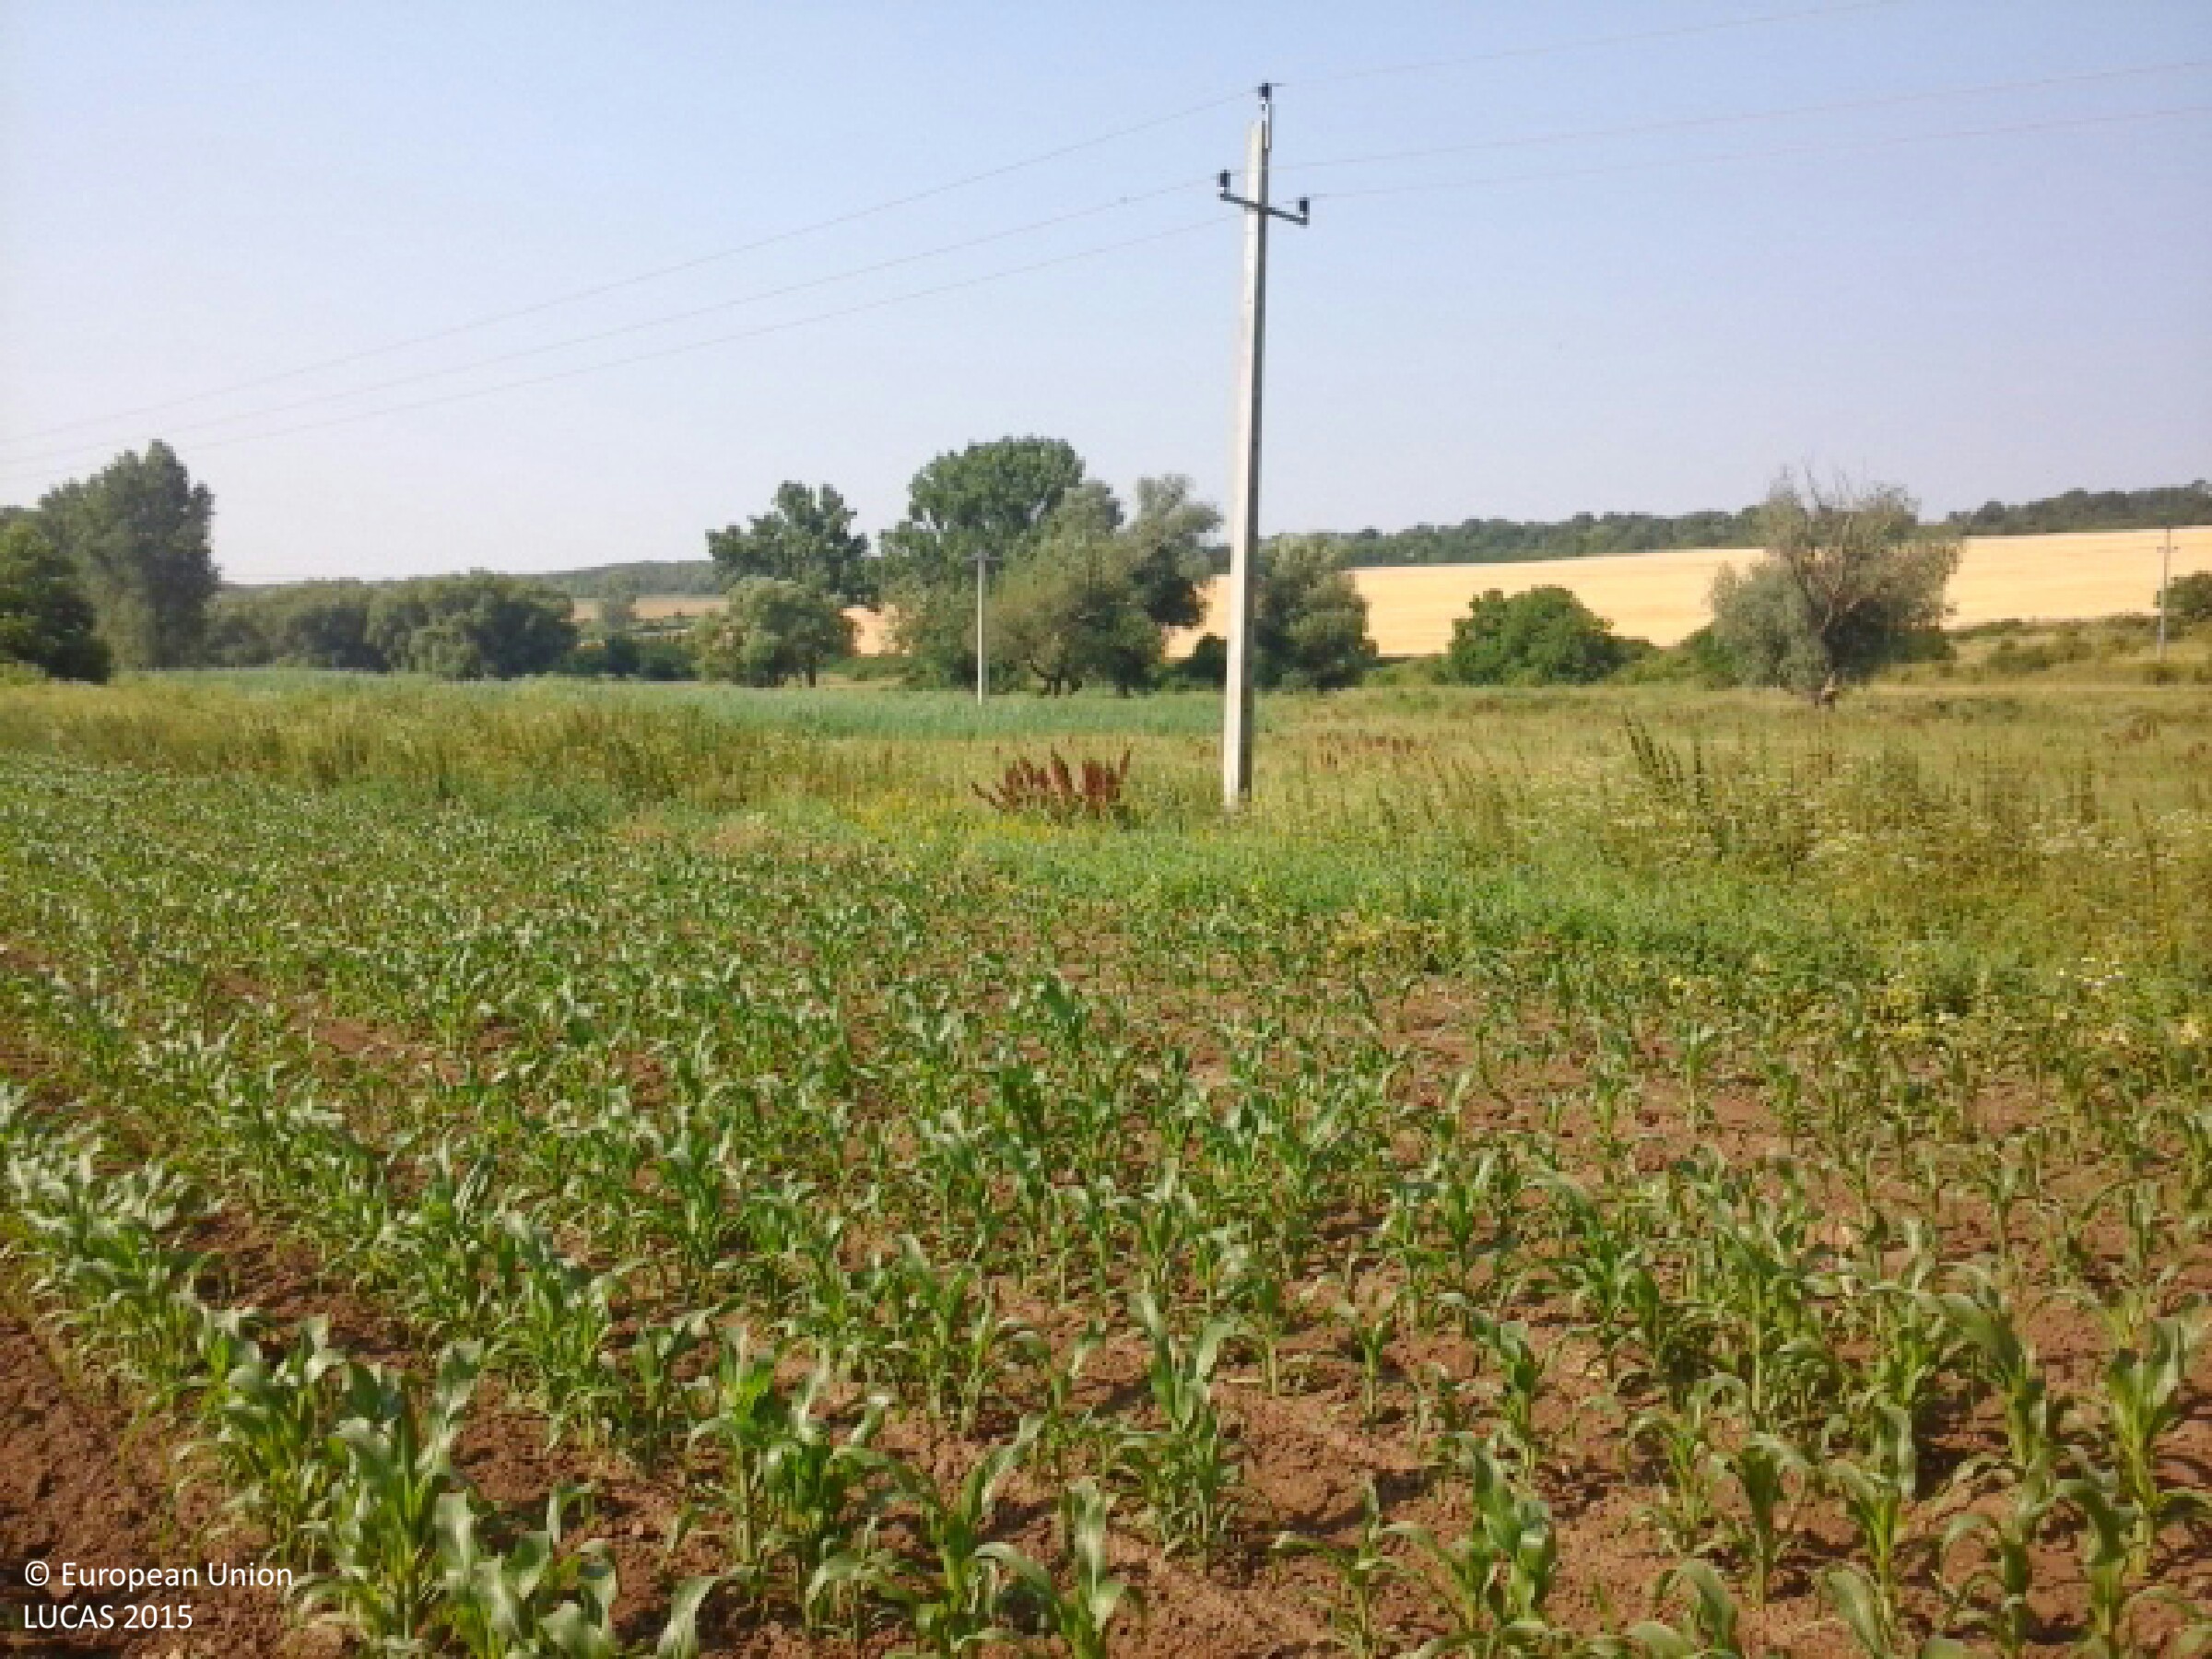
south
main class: Cropland
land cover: Maize
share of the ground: 25 - 50 %
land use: Agriculture (excluding fallow land and kitchen gardens)
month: July
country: HU
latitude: 48.1743
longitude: 21.0540
